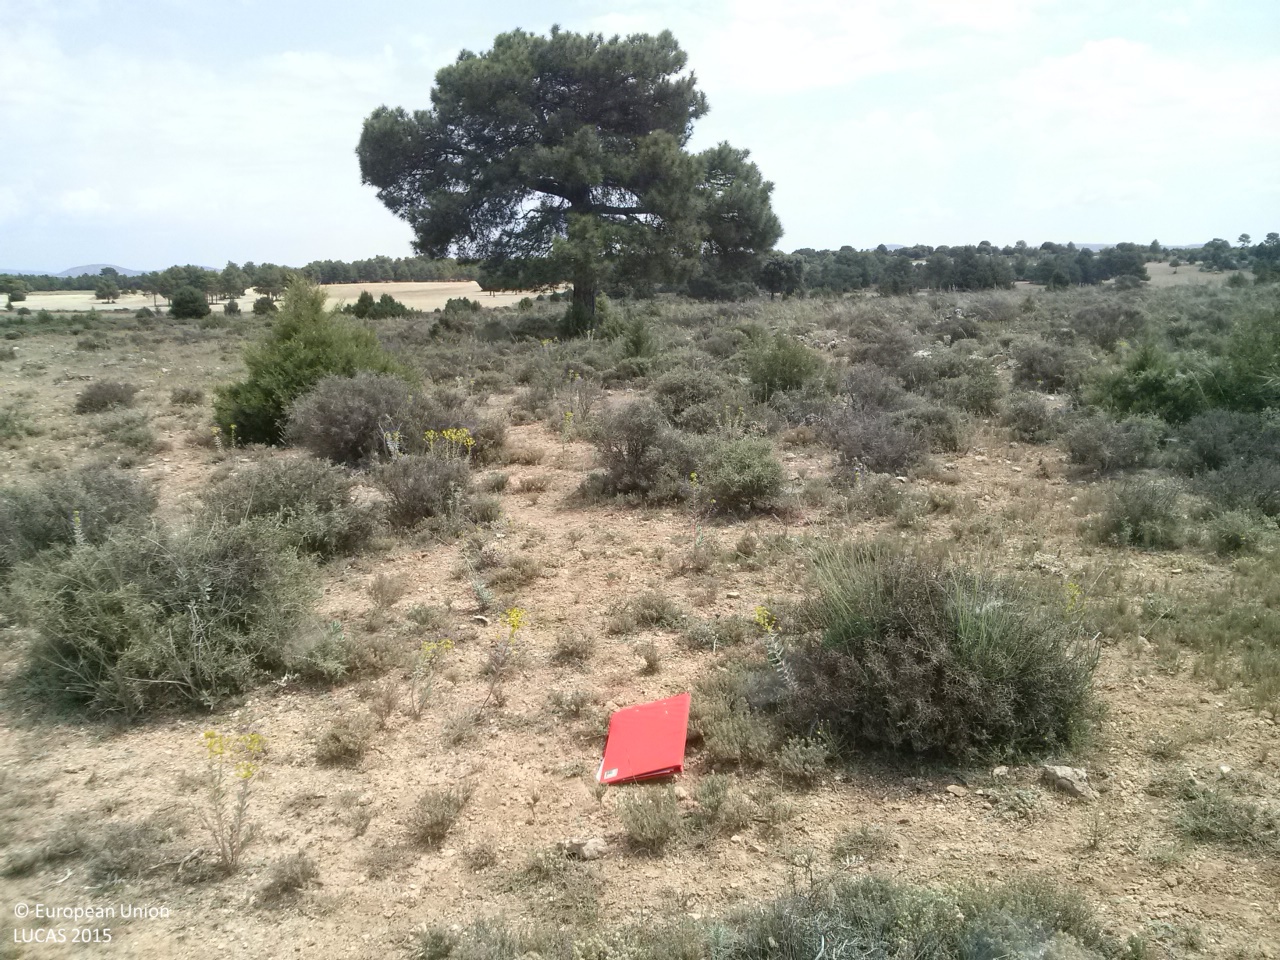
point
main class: Shrubland
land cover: Shrubland without tree cover
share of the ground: 25 - 50 %
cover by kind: shrubs 40 %, herbaceous plants 30 %, unconsolidated bare surface 30 %
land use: Agriculture (excluding fallow land and kitchen gardens)
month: June
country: ES
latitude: 39.9517
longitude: -1.8221
